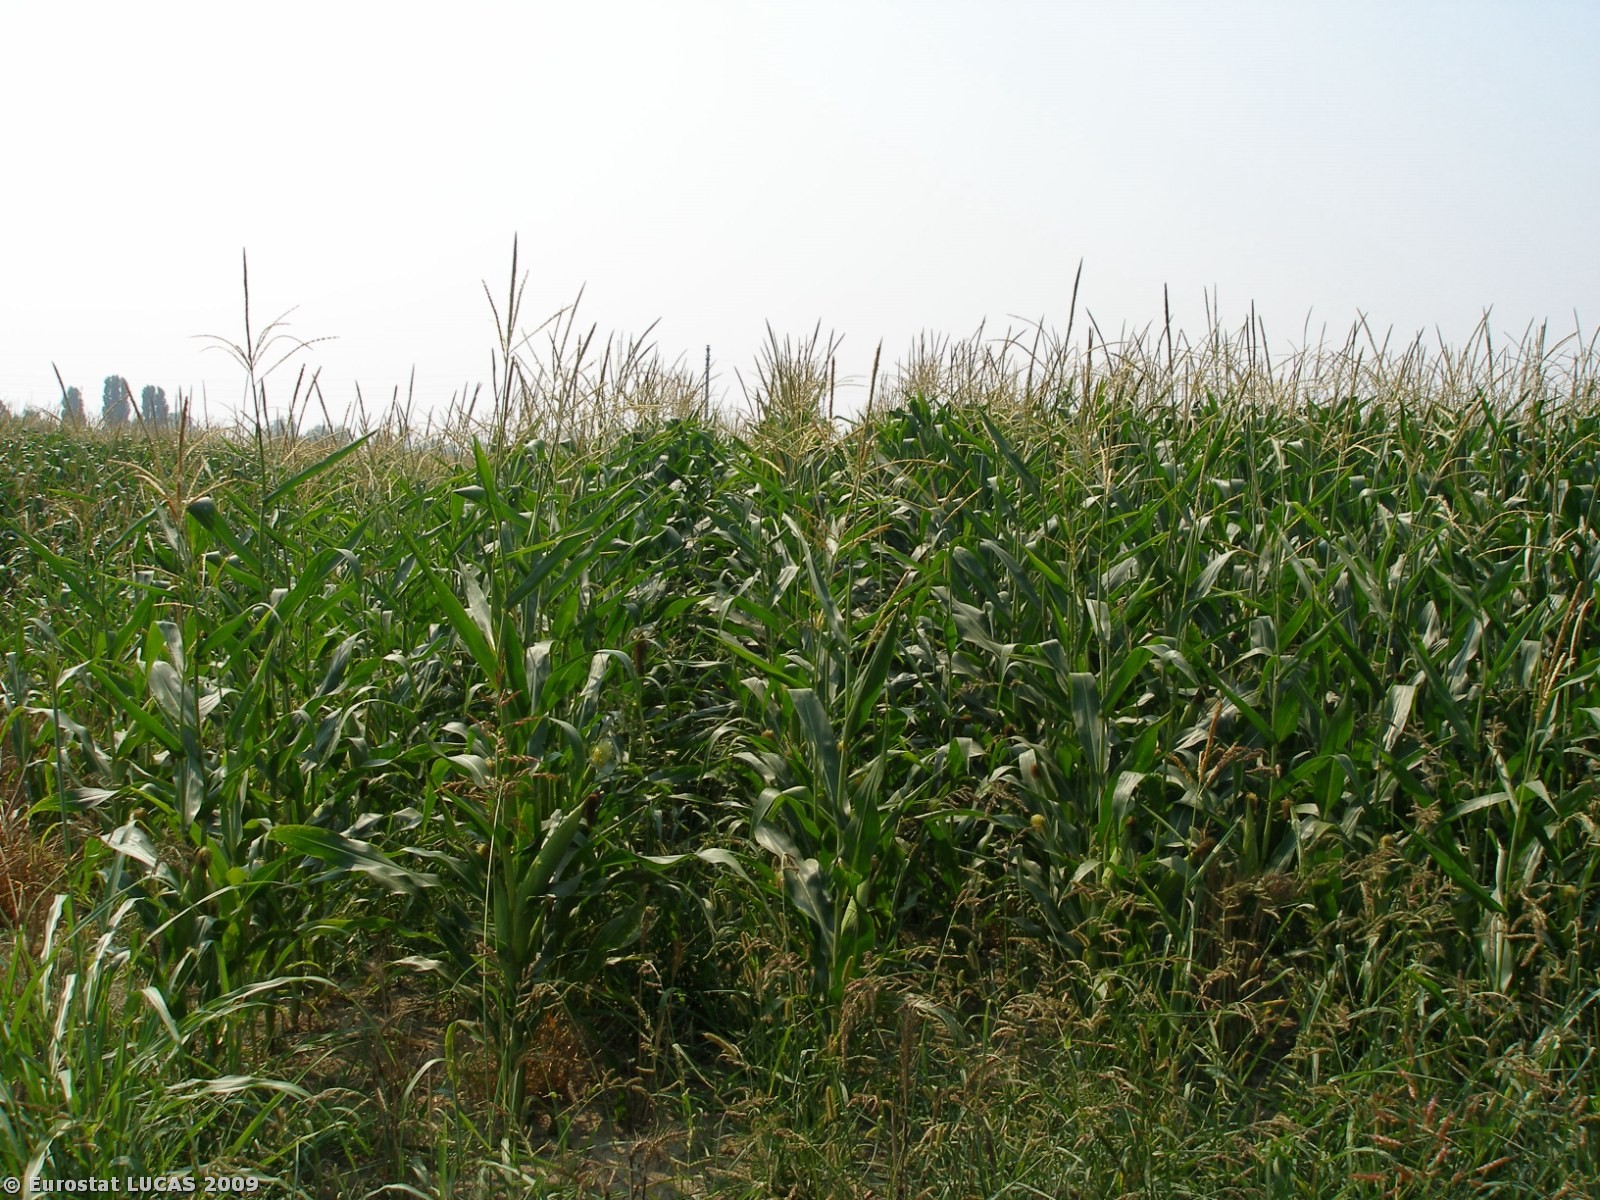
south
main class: Cropland
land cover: Maize
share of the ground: > 75 %
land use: Agriculture (excluding fallow land and kitchen gardens)
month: July
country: IT
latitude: 44.9317
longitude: 11.7073
